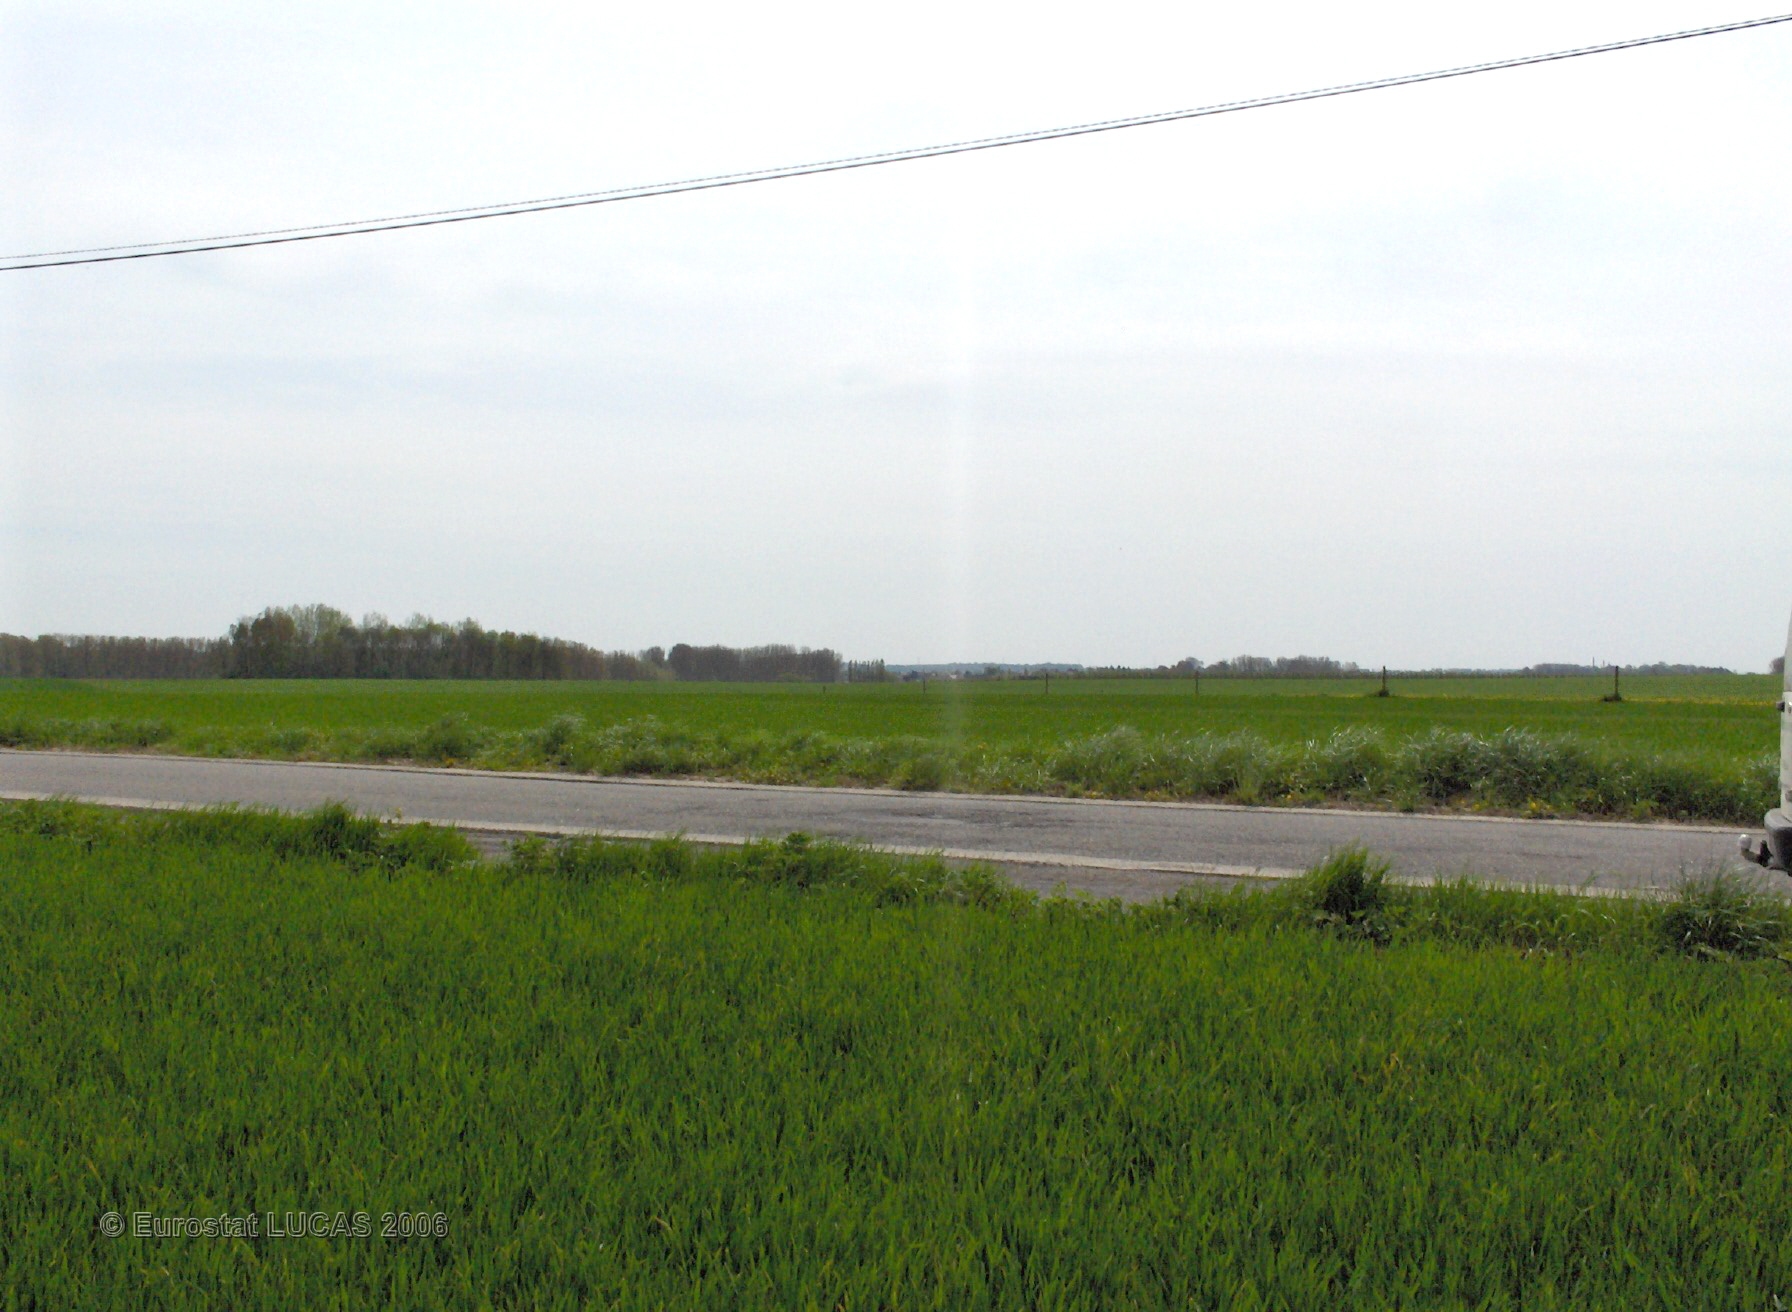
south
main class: Cropland
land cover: Common wheat
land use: Agriculture (excluding fallow land and kitchen gardens)
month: May
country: BE
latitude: 50.6968
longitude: 5.2266
